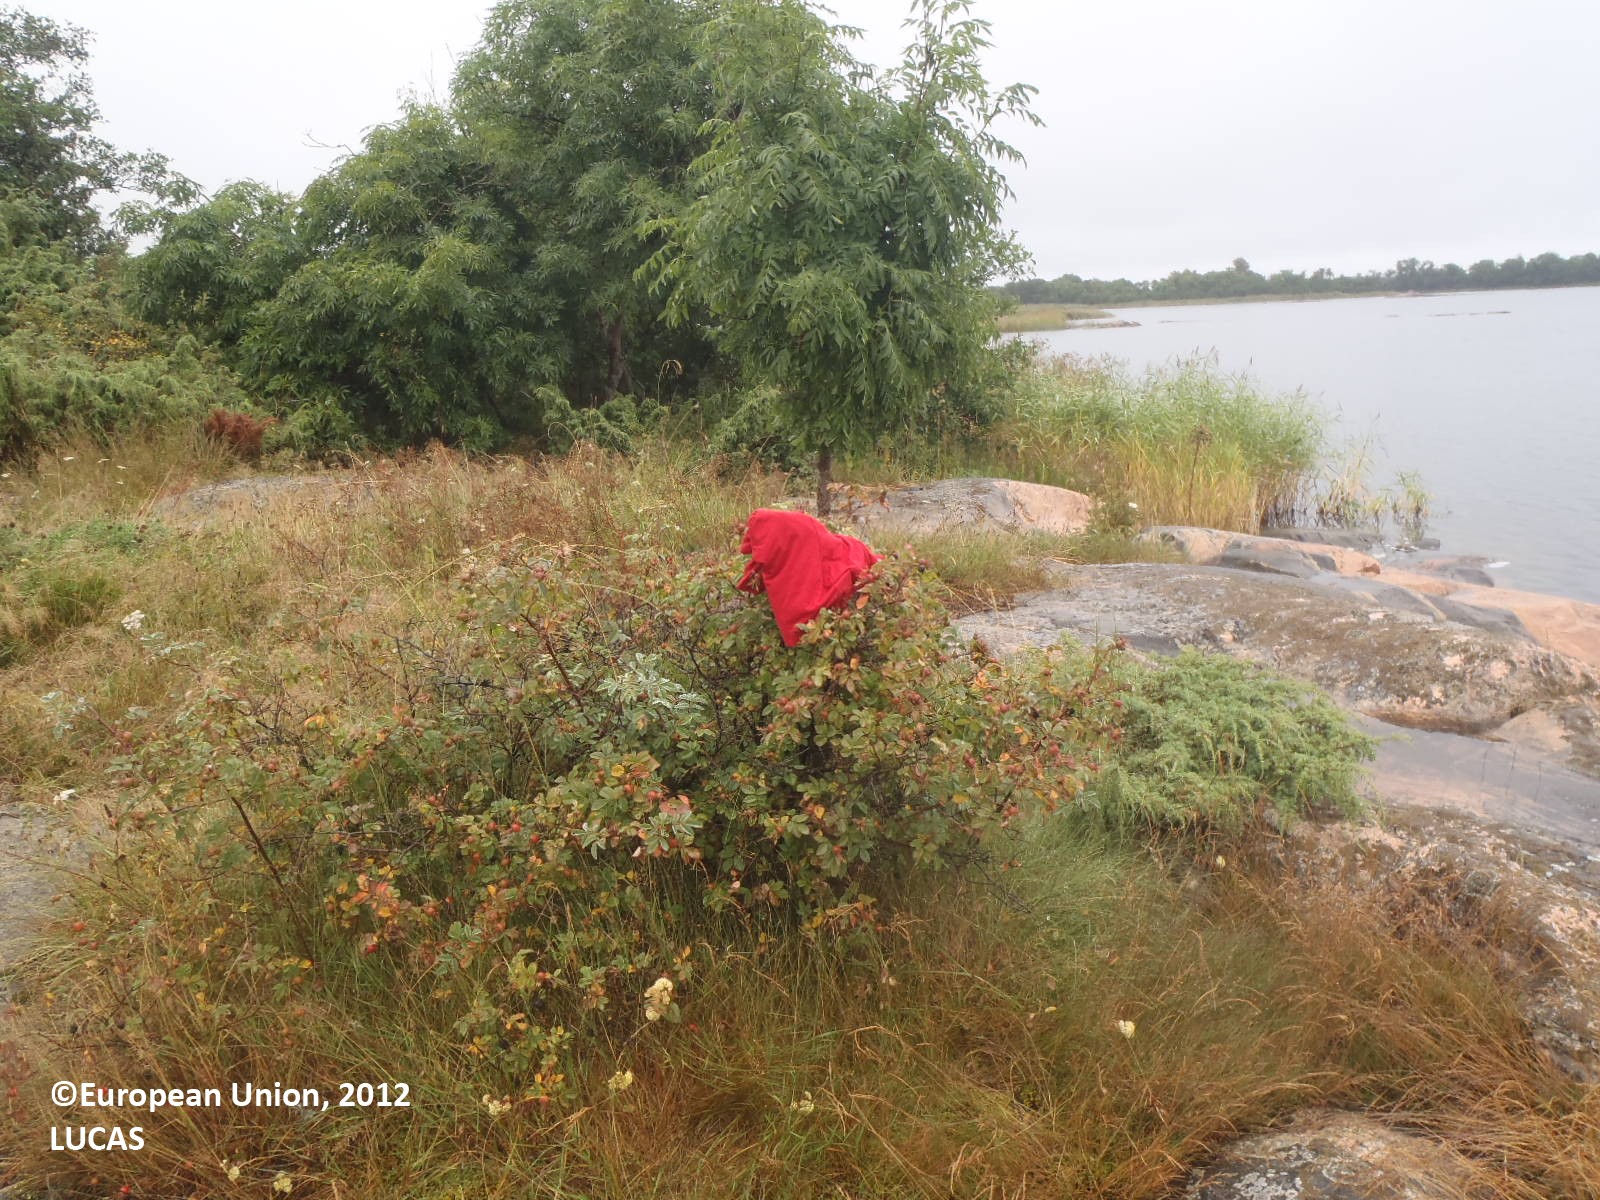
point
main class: Grassland
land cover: Grassland with sparse tree/shrub cover
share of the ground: > 75 %
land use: Semi-natural and natural areas not in use
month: August
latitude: 60.4252
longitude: 20.9674
